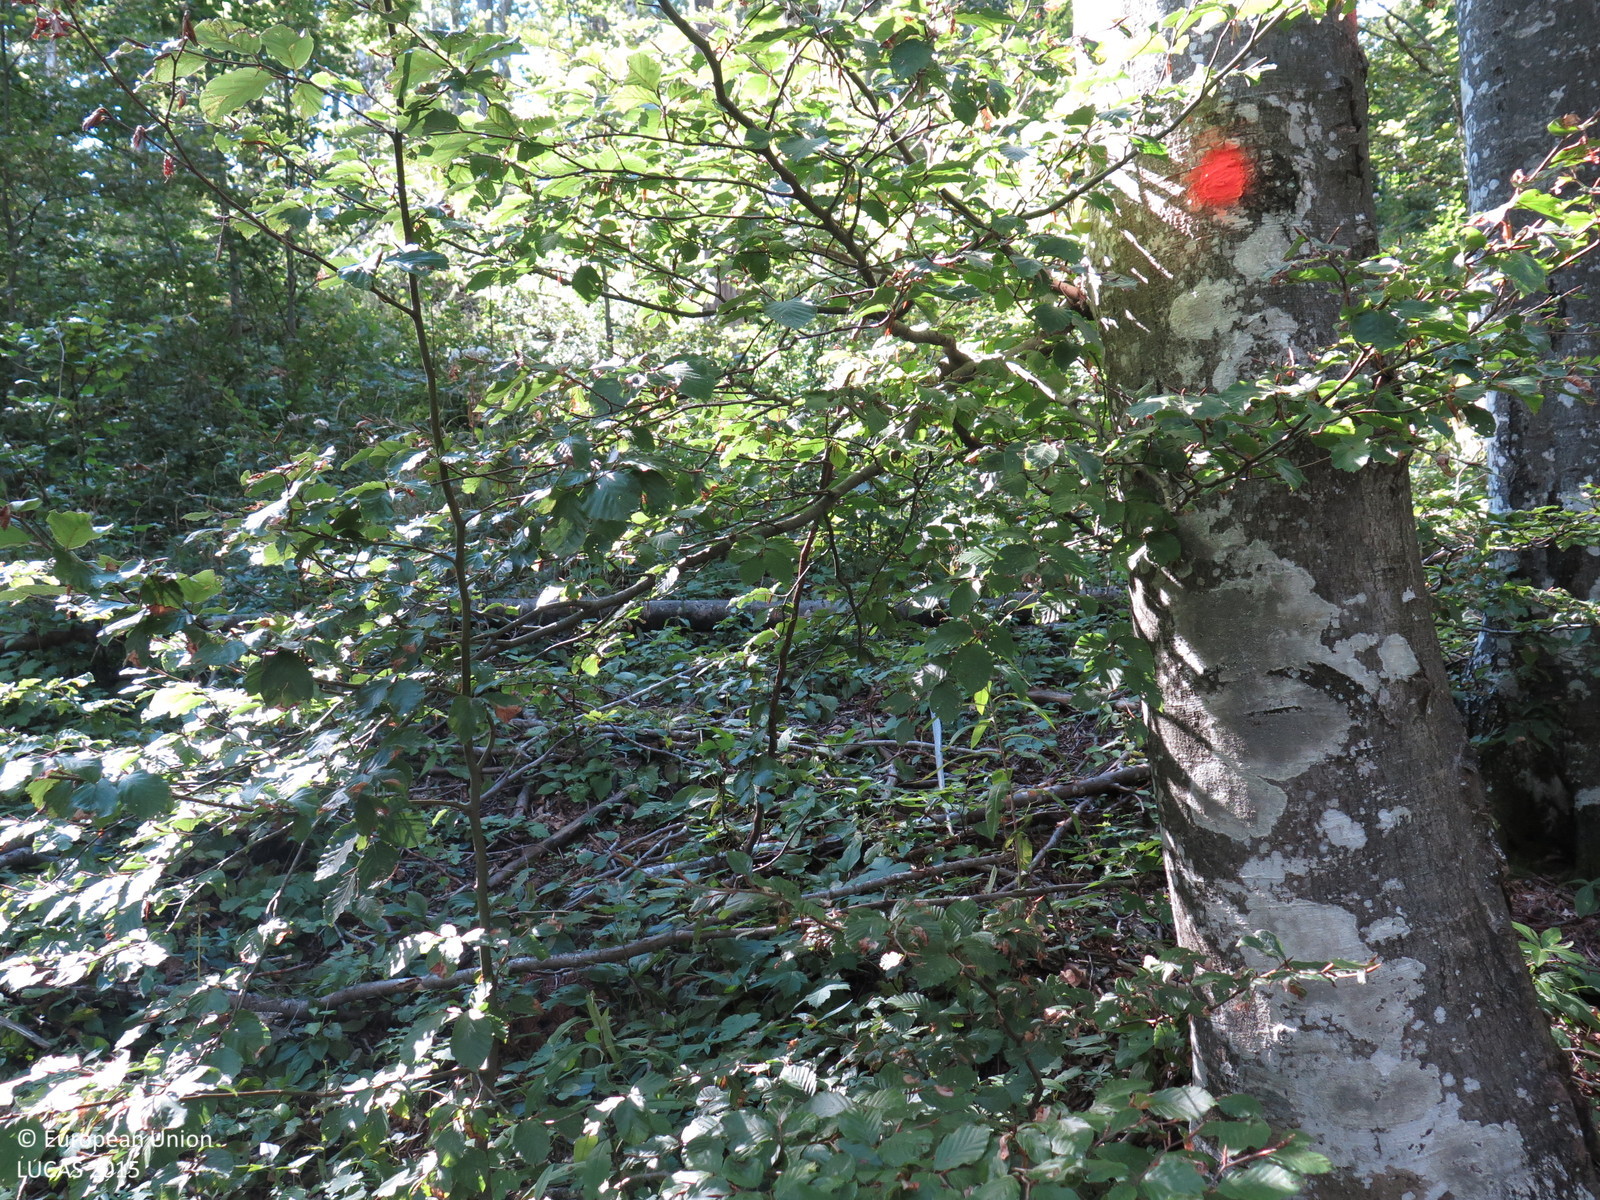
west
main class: Woodland
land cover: Other mixed woodland
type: alpine coniferous forest
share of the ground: > 75 %
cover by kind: coniferous forest trees 75 %, broadleaved forest trees 25 %
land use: Forestry
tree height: > 5 m
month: September
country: HR
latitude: 45.3982
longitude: 14.7346
